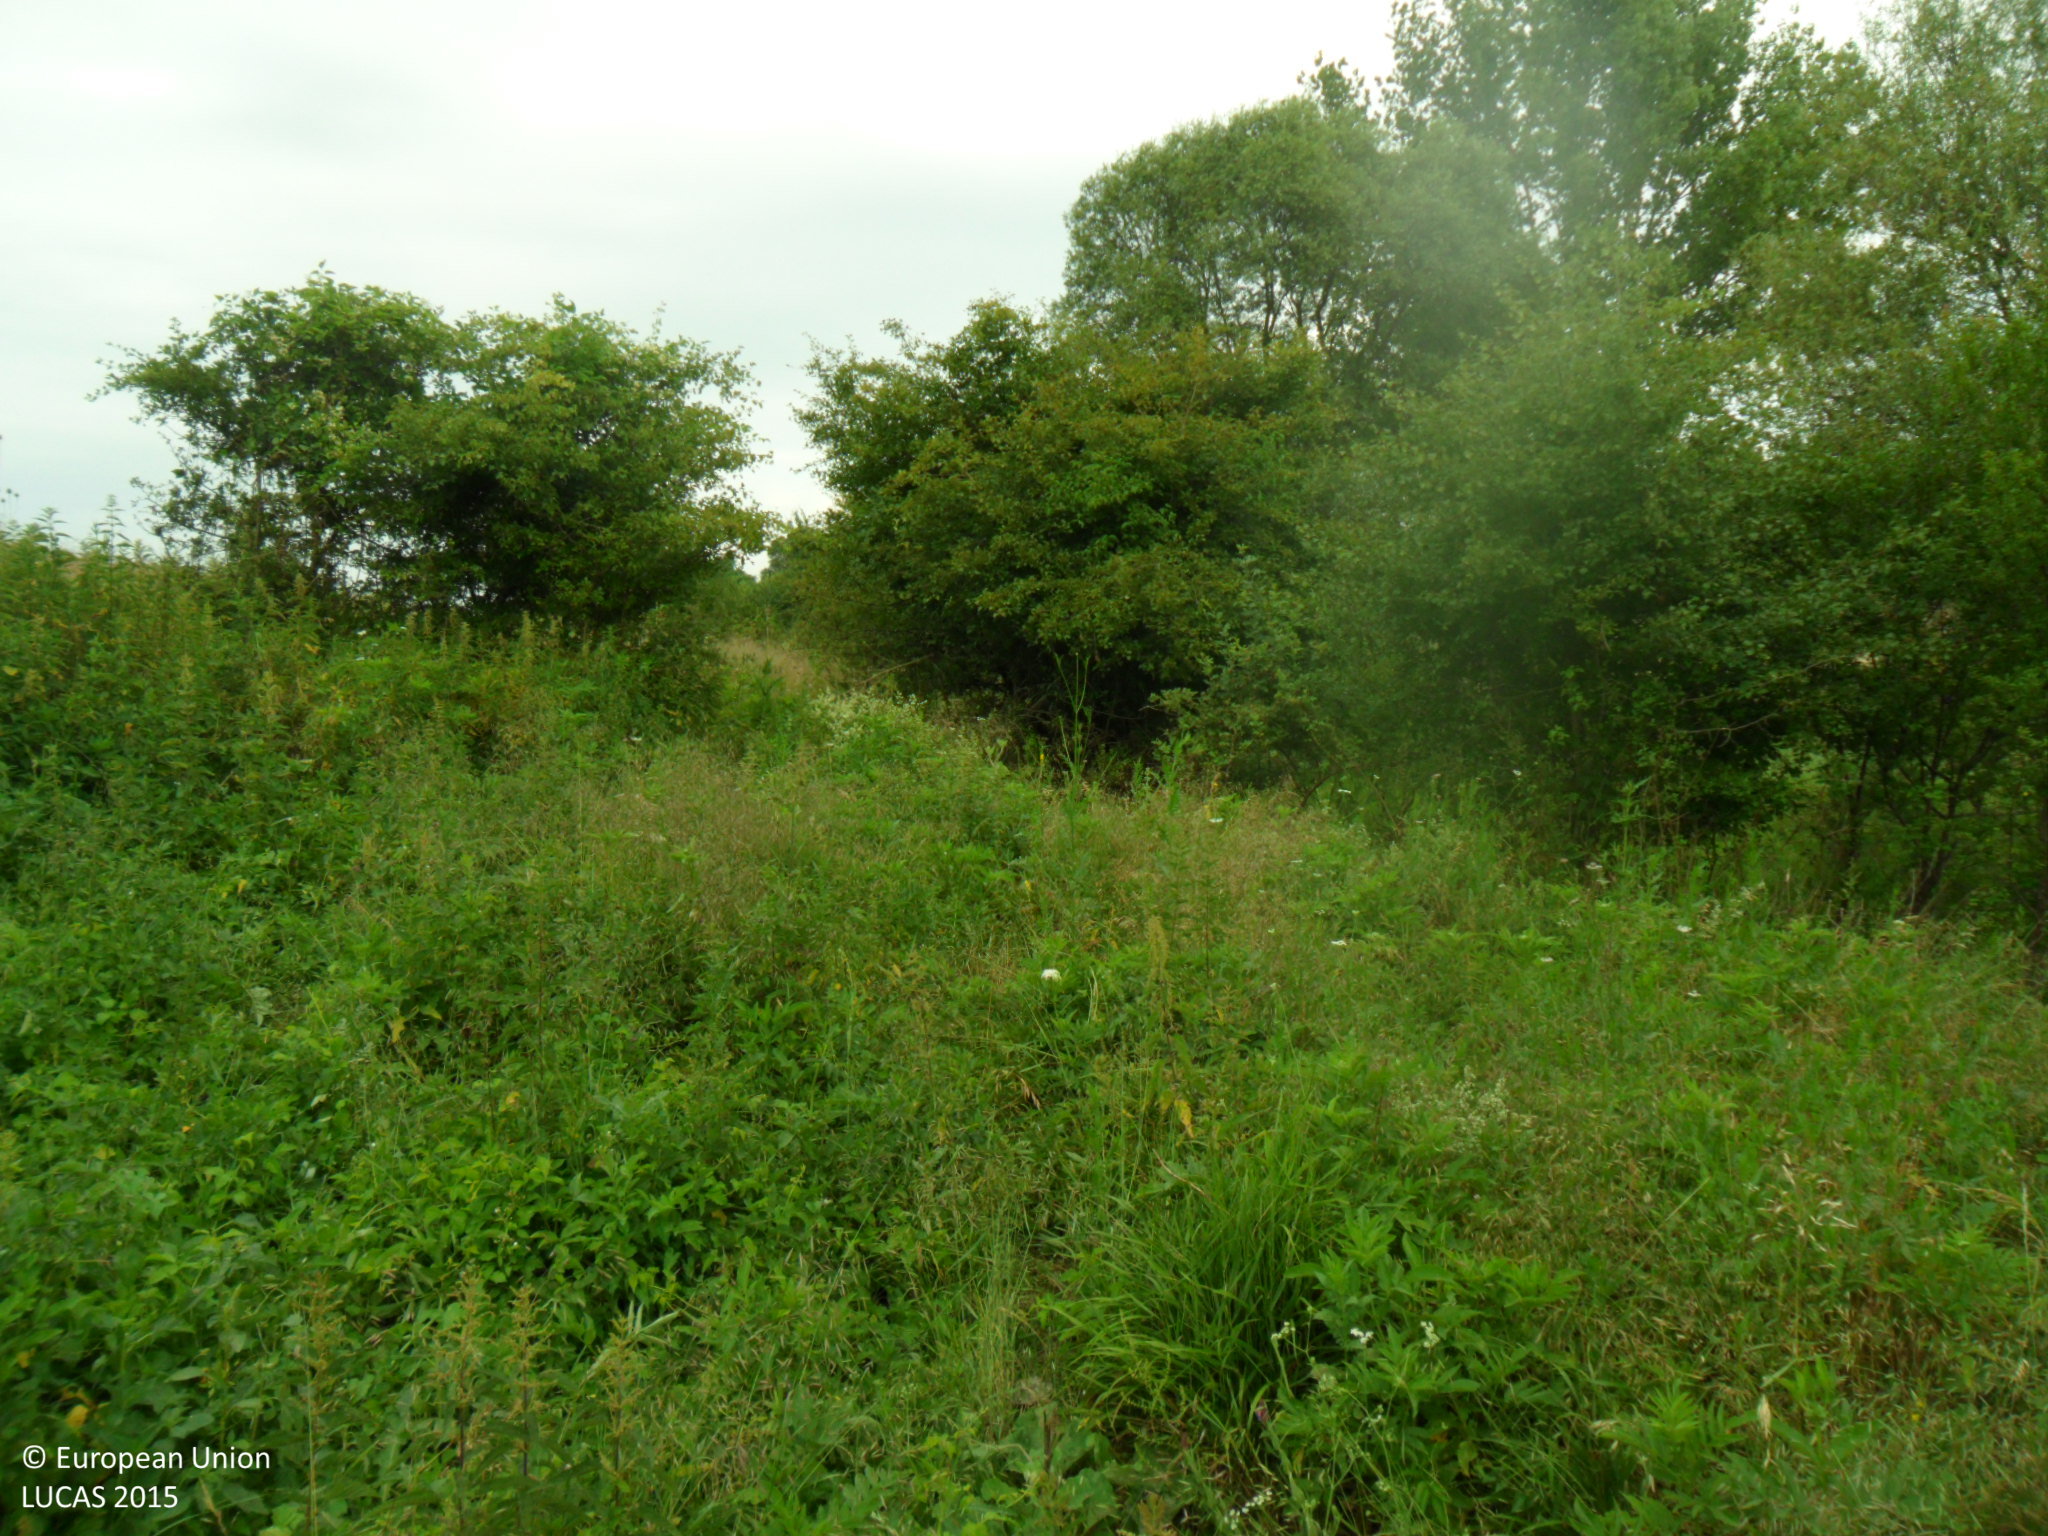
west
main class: Shrubland
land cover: Shrubland with sparse tree cover
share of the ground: > 75 %
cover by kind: herbaceous plants 60 %, shrubs 35 %, broadleaved forest trees 5 %
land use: Agriculture (excluding fallow land and kitchen gardens)
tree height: < 5 m
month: June
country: BG
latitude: 43.1645
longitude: 26.9501
